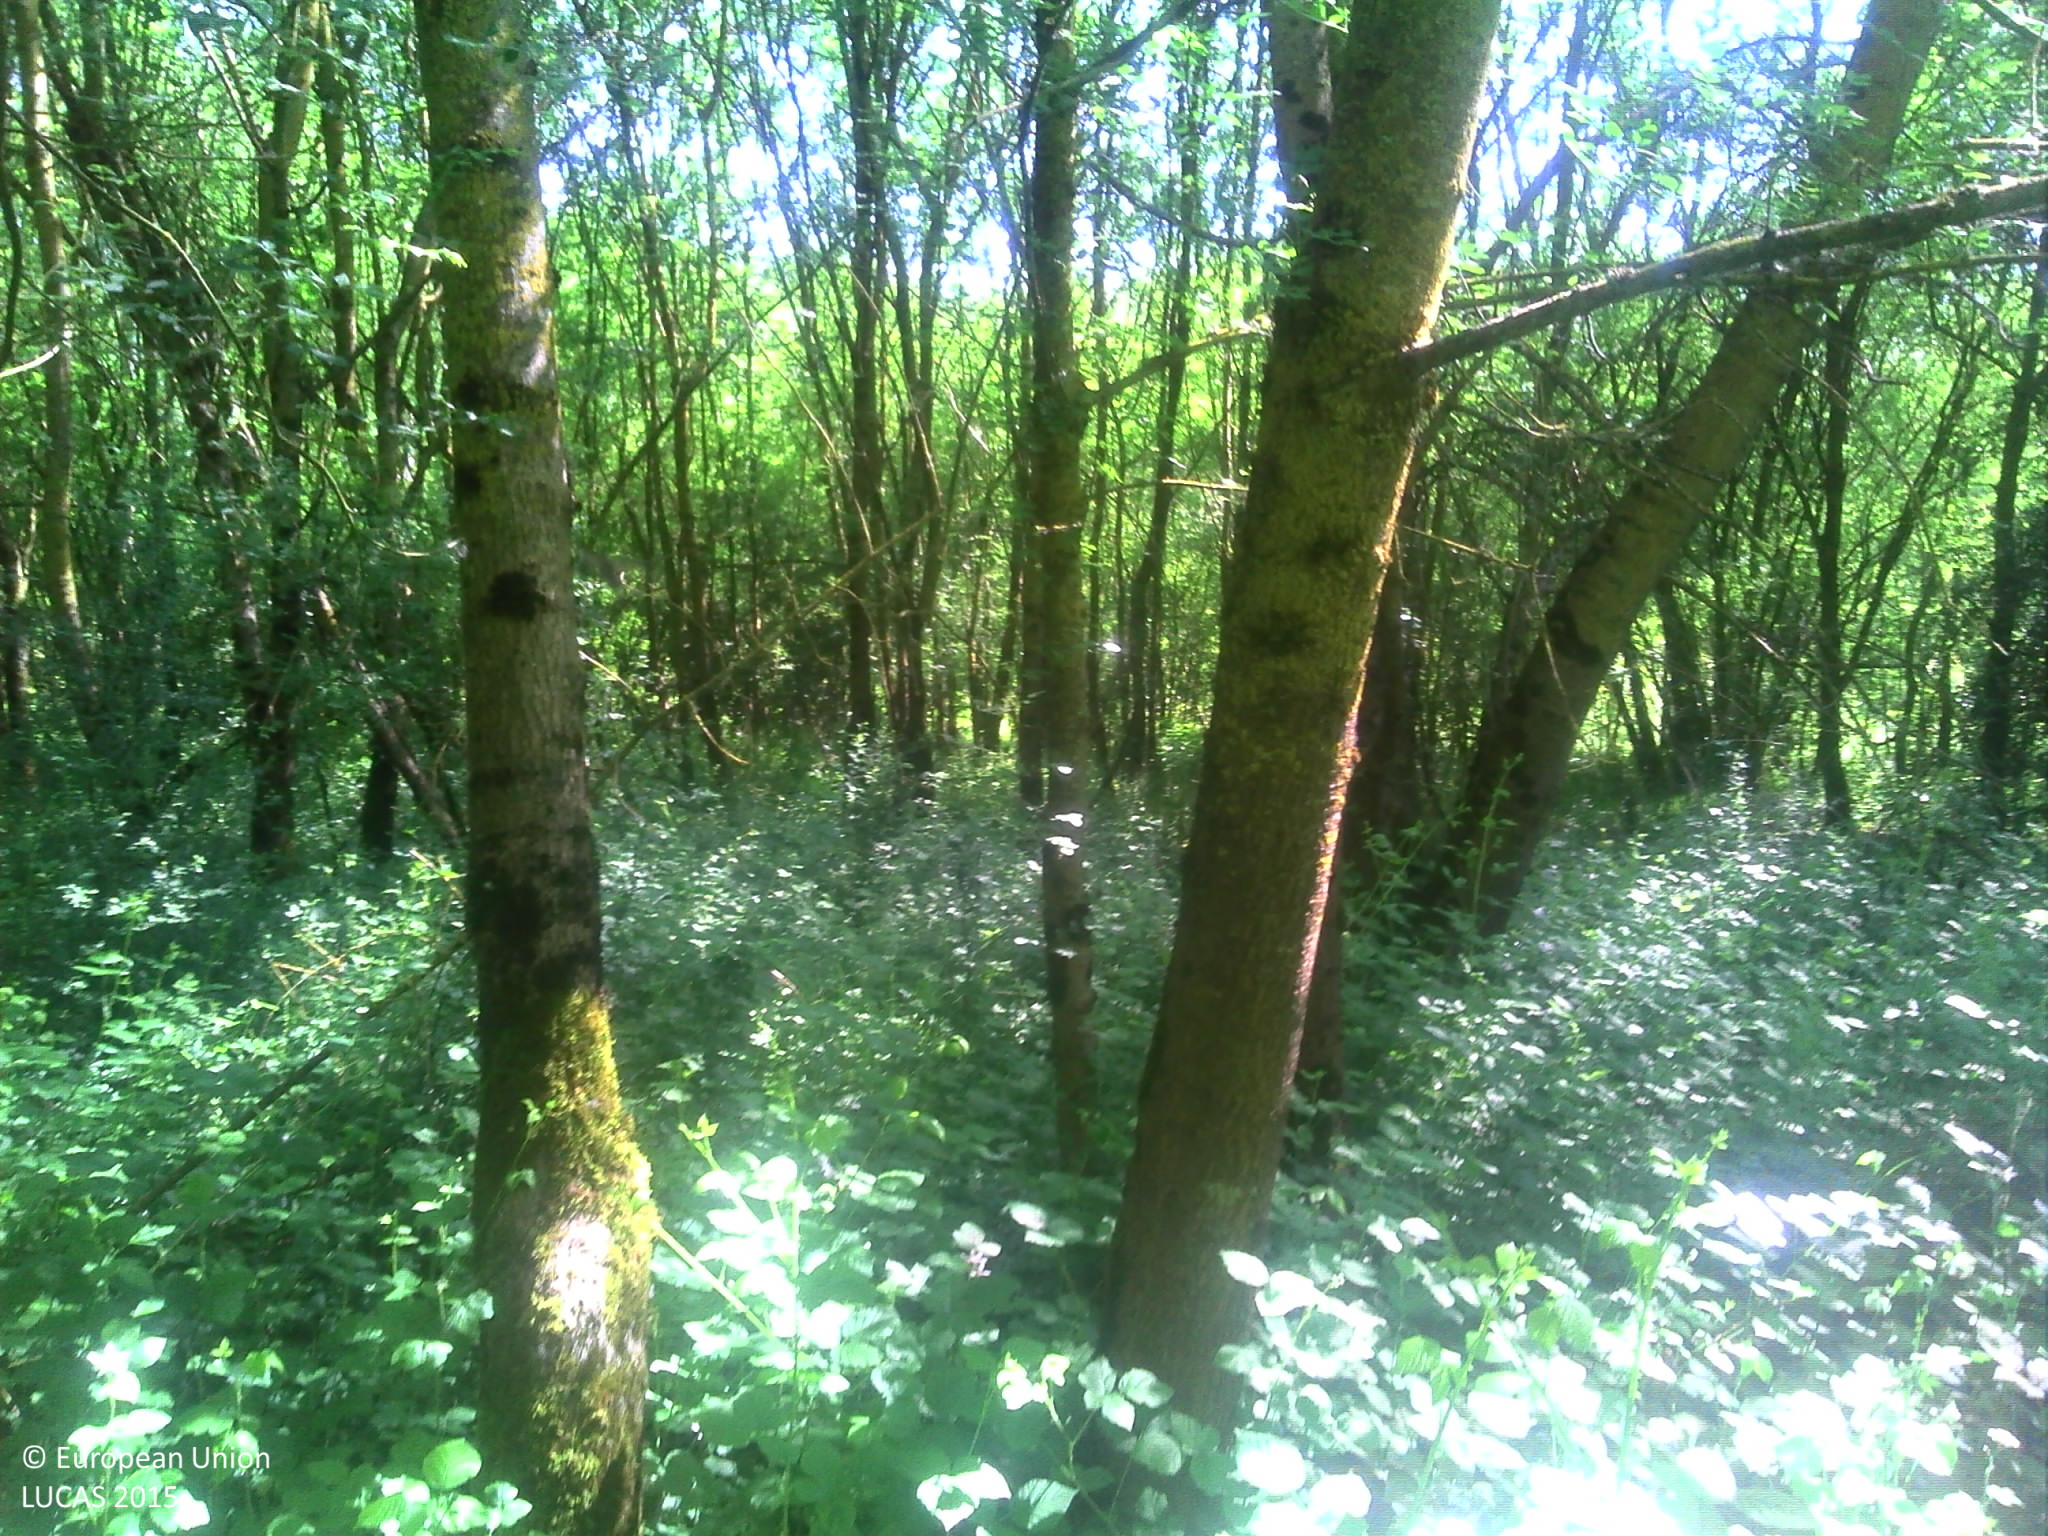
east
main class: Woodland
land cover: Broadleaved woodland
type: floodplain forest
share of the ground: > 75 %
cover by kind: broadleaved forest trees 90 %, herbaceous plants 10 %
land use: Forestry
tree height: > 5 m
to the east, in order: Broadleaved woodland; Spontaneously vegetated surfaces; Broadleaved woodland; Spontaneously vegetated surfaces; Lines of trees; Spontaneously vegetated surfaces; Broadleaved woodland; Grass margins; Tracks; Grass margins; Spontaneously vegetated surfaces; Broadleaved woodland
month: May
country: FR
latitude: 47.3844
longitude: -0.9638
